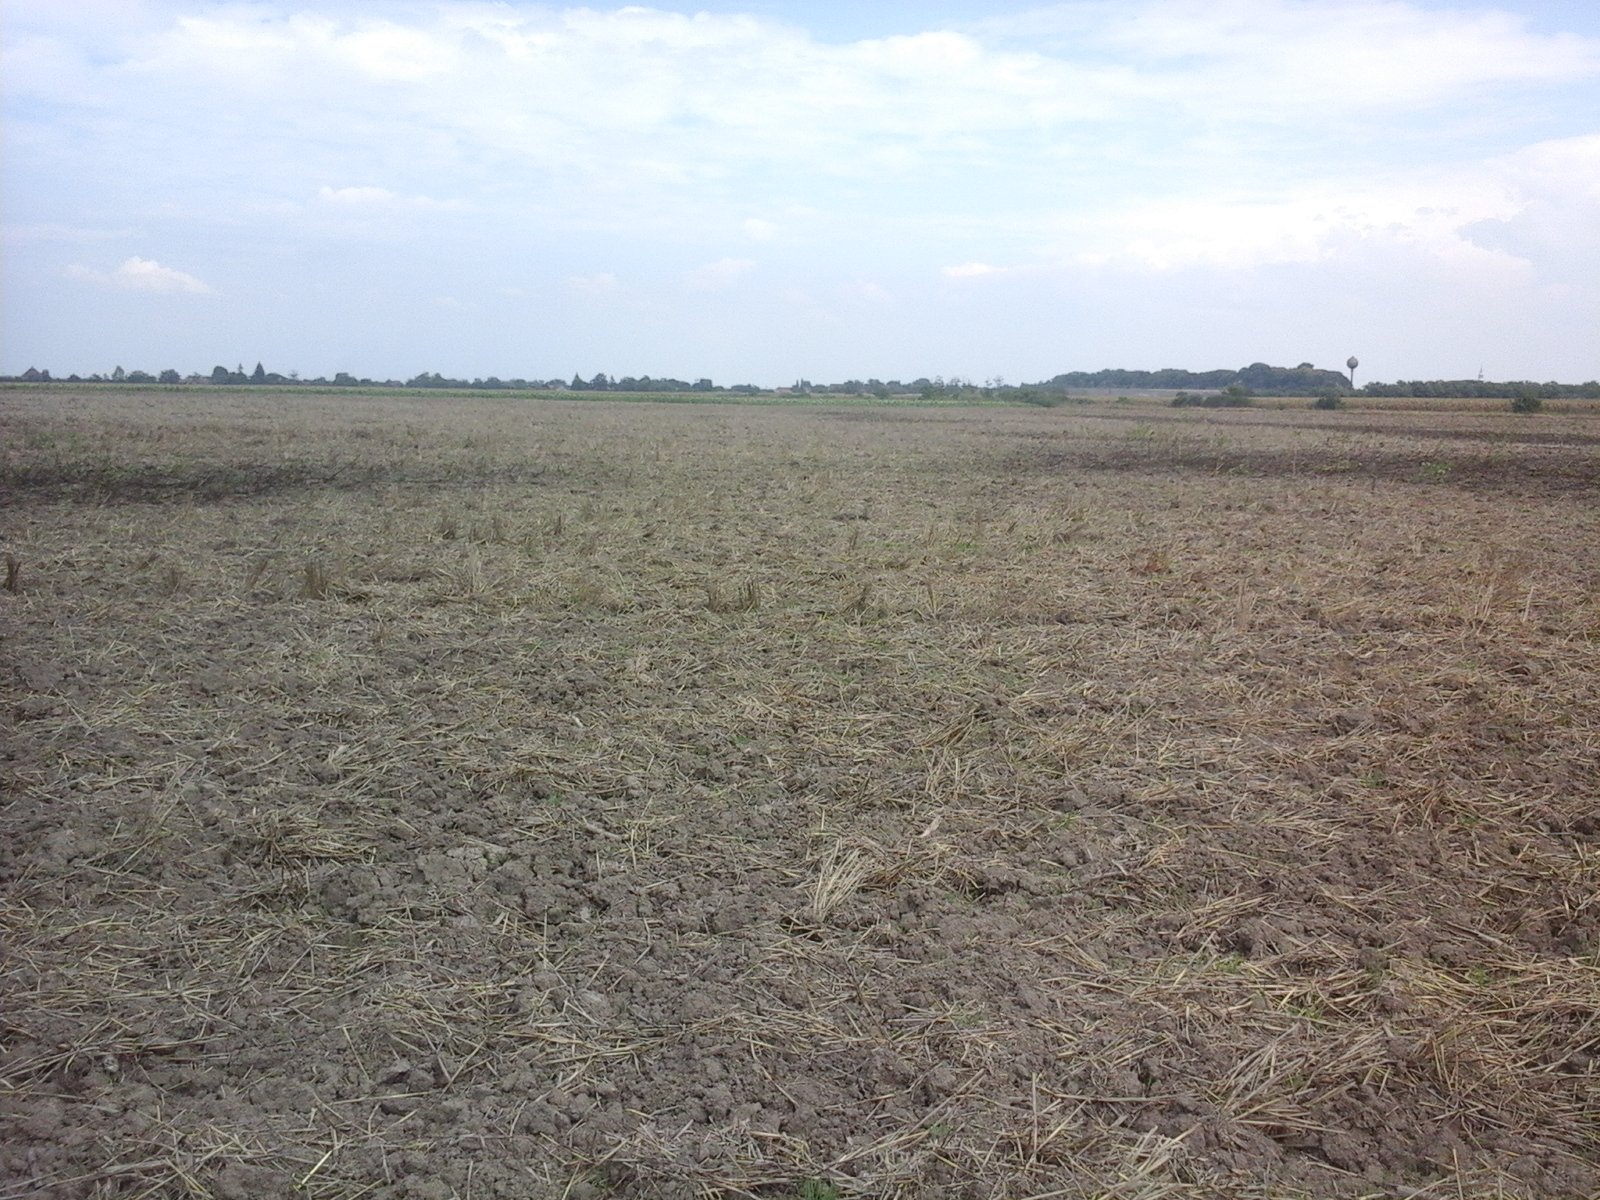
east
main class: Cropland
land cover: Common wheat
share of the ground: < 10 %
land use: Agriculture (excluding fallow land and kitchen gardens)
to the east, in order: Common wheat
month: August
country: RO
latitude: 46.7431
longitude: 21.7036
